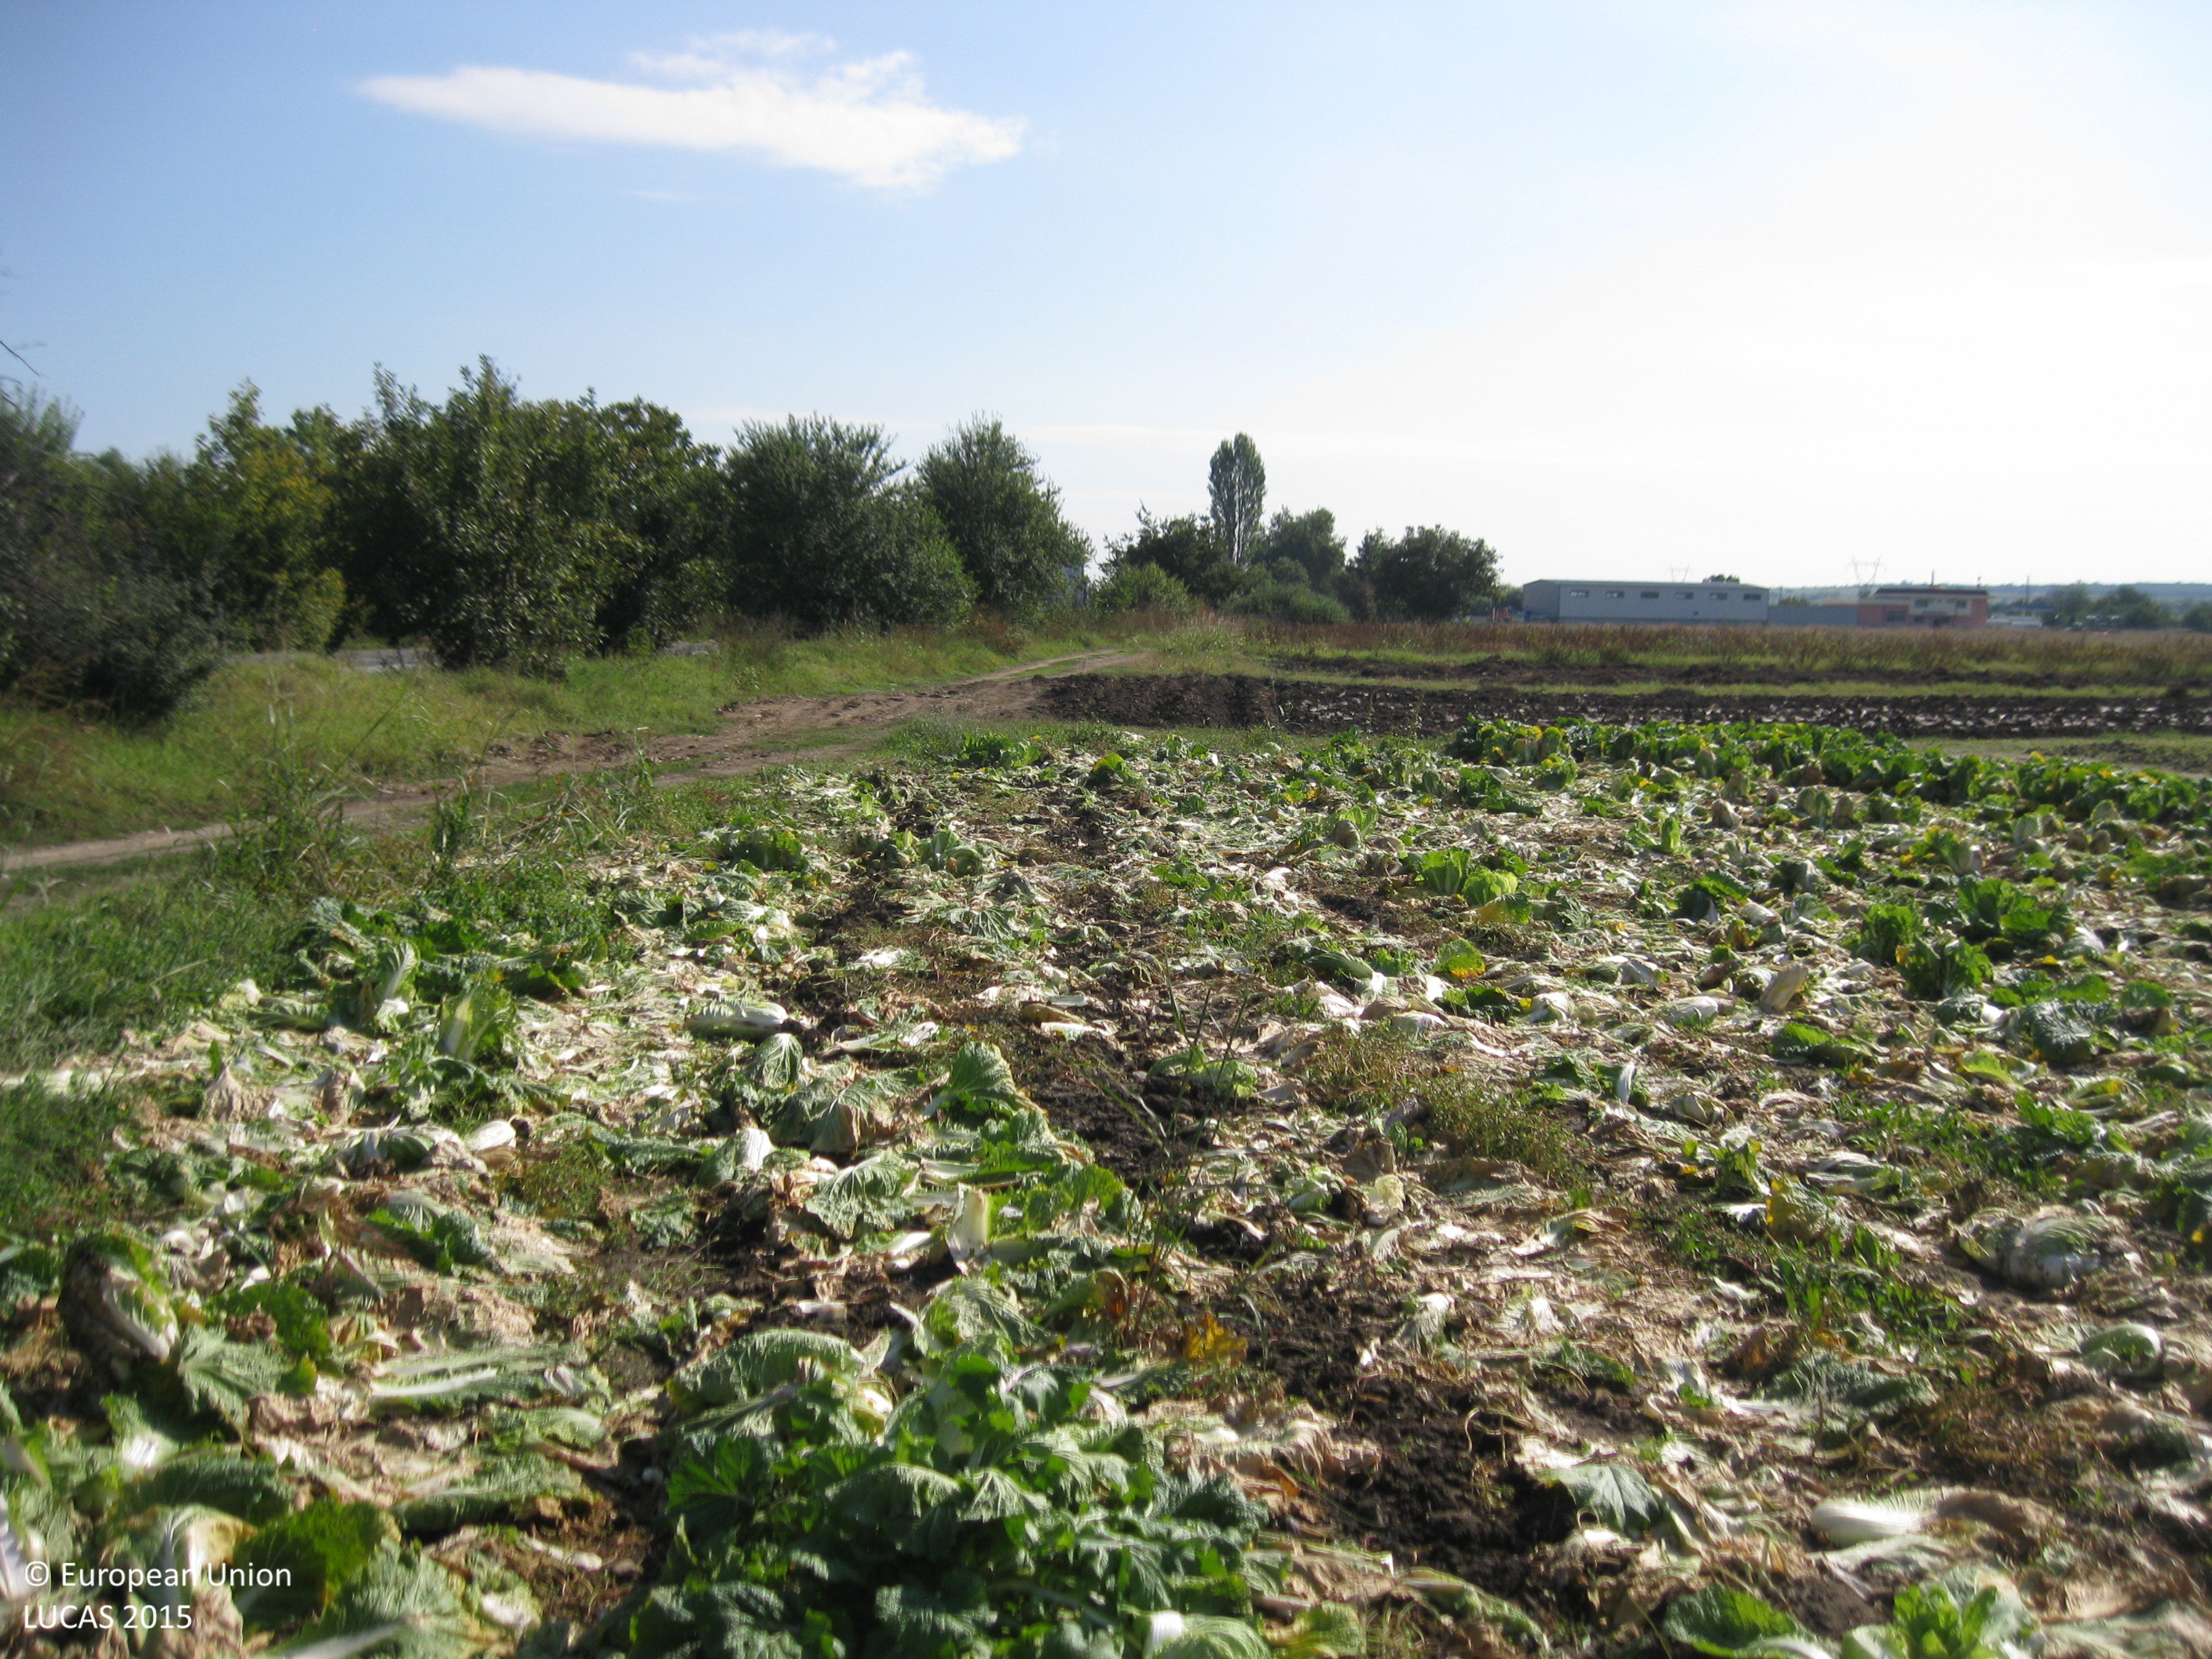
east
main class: Cropland
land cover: Other fresh vegetables
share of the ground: > 75 %
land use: Agriculture (excluding fallow land and kitchen gardens)
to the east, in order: Other fresh vegetables; Tracks; Grass margins; Lines of trees; Grass margins; Paved roads, cycling and walking lanes; Grass margins; Lines of trees; Tracks; Grassland without tree/shrub cover; Tracks; Shrubland without tree cover
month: October
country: BG
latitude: 42.1388
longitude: 24.9737
